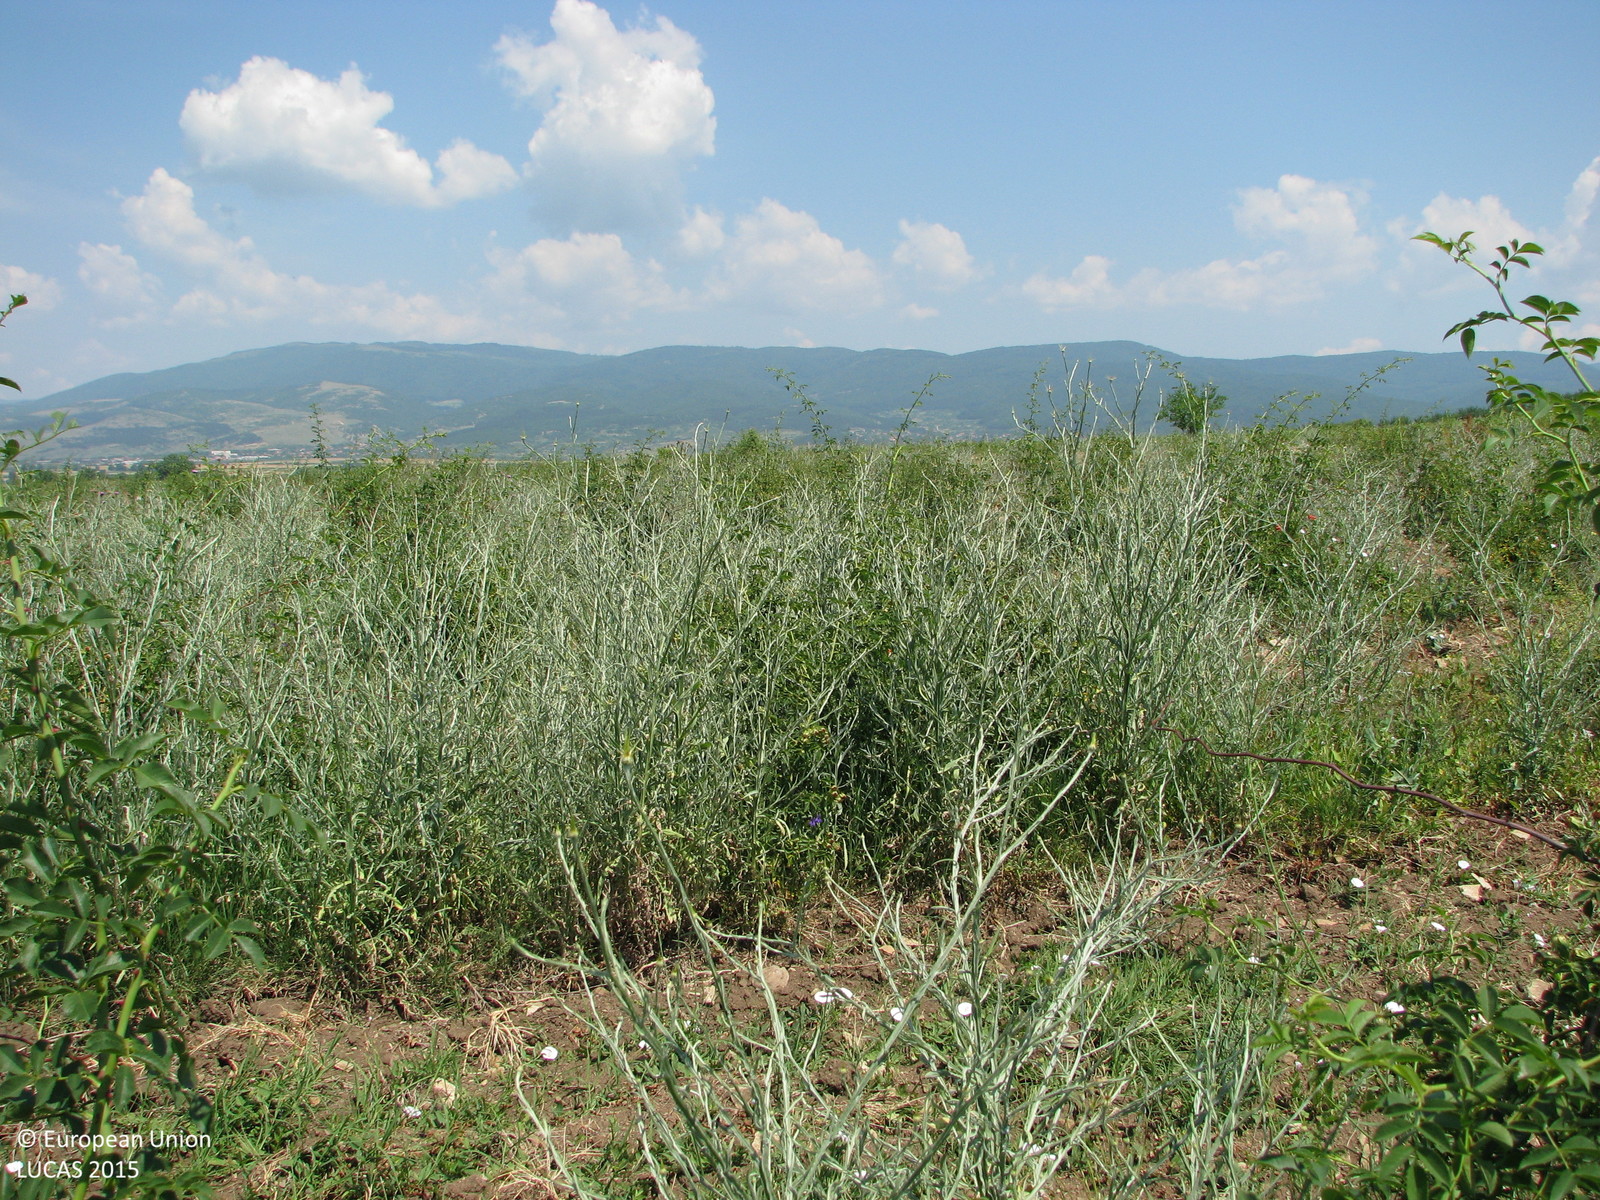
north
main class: Cropland
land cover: Other fruit trees and berries
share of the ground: < 10 %
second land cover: Spontaneously vegetated surfaces
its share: > 75 %
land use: Agriculture (excluding fallow land and kitchen gardens)
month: June
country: BG
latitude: 42.6059
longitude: 26.2131
